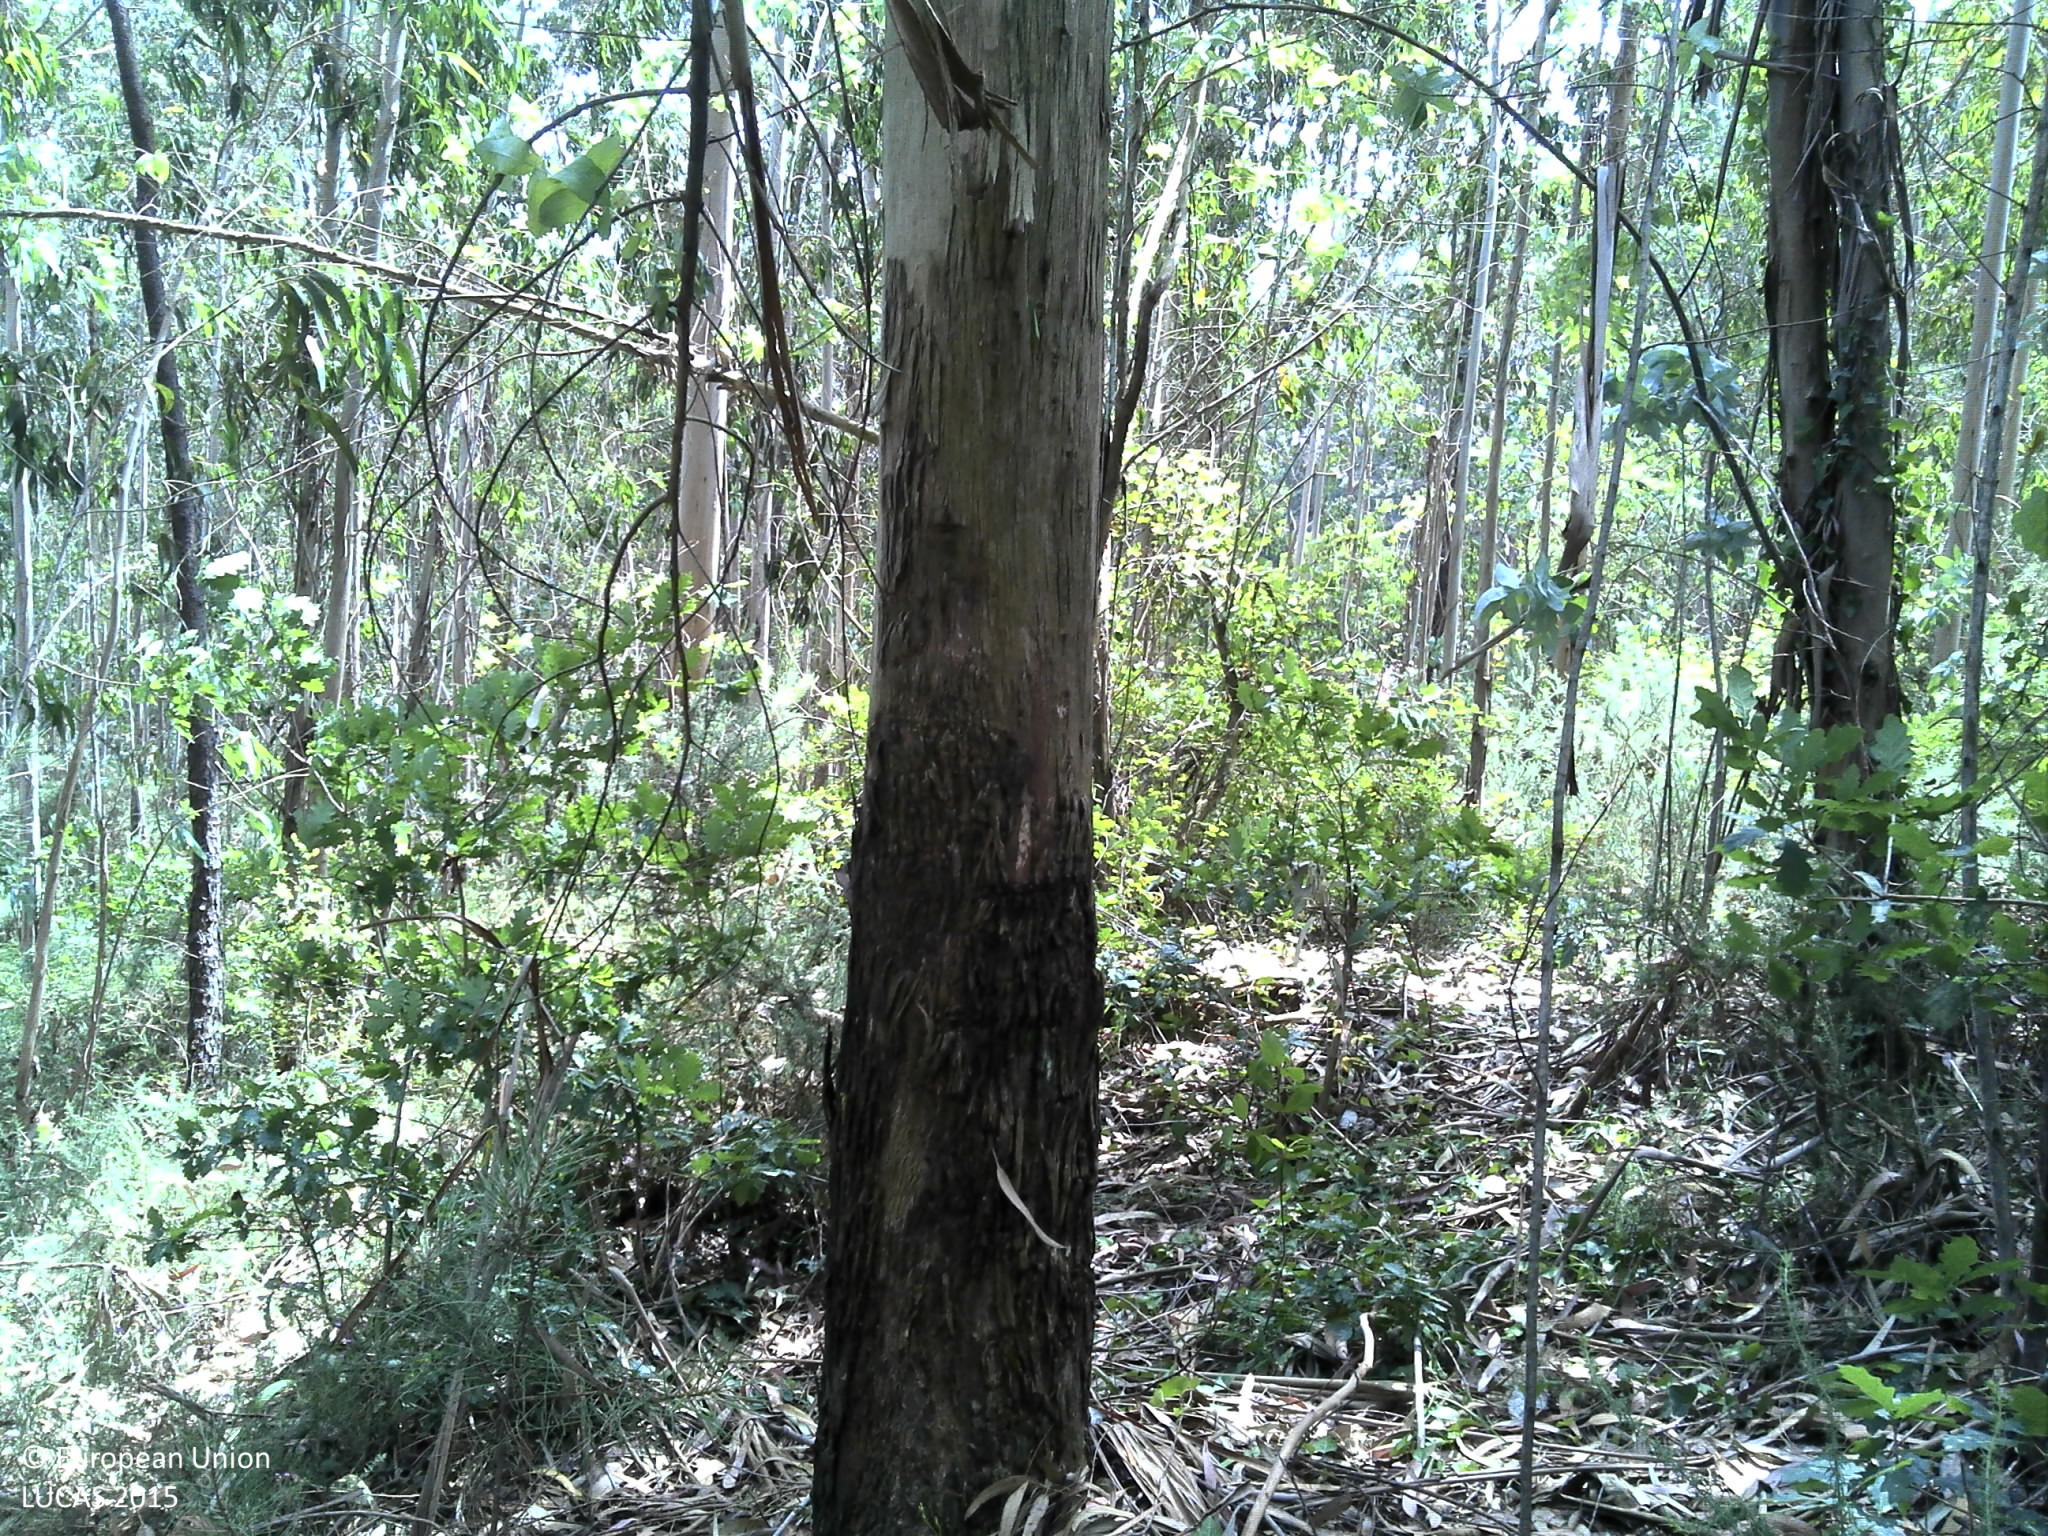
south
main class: Woodland
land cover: Broadleaved woodland
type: exotic forest
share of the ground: 25 - 50 %
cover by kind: broadleaved forest trees 40 %, unconsolidated bare surface 25 %, shrubs 20 %, herbaceous plants 10 %, coniferous forest trees 5 %
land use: Forestry
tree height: > 5 m
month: May
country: PT
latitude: 41.4485
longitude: -8.6032
